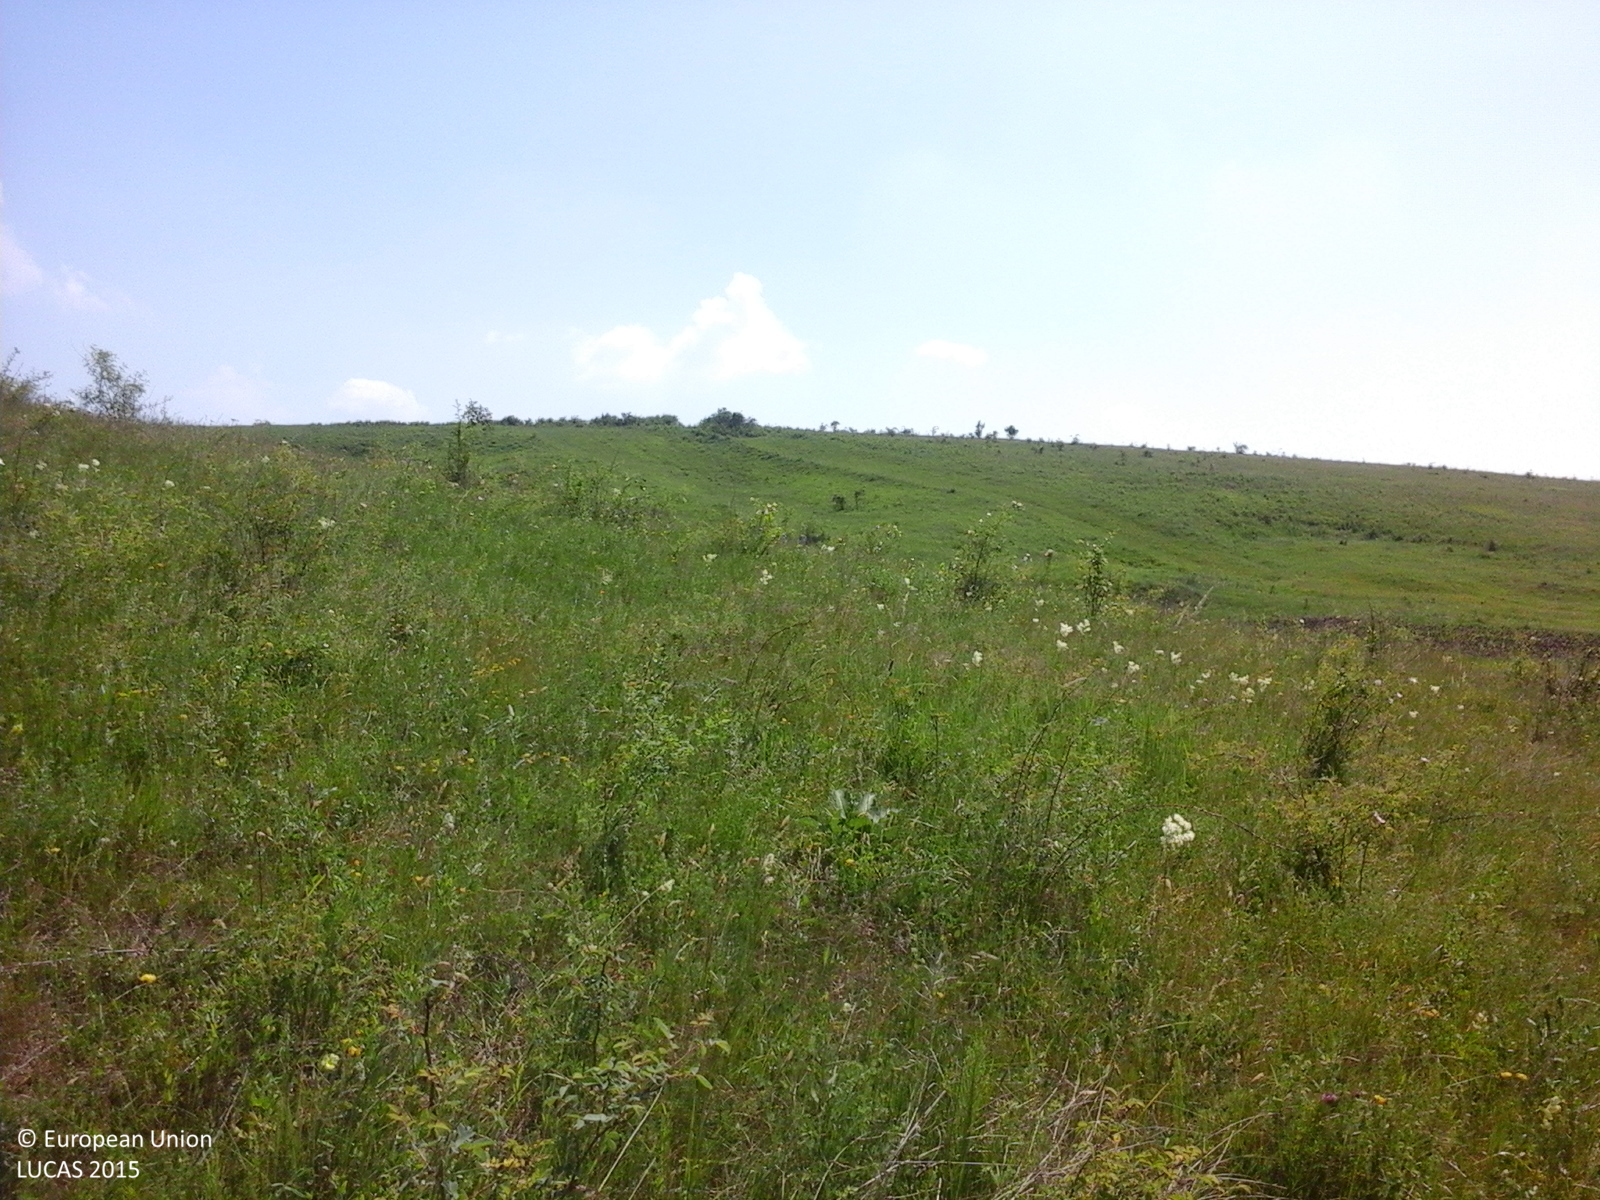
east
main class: Grassland
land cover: Grassland without tree/shrub cover
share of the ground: > 75 %
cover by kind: herbaceous plants 100 %
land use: Agriculture (excluding fallow land and kitchen gardens)
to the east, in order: Grassland without tree/shrub cover; Grassland with sparse tree/shrub cover
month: June
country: RO
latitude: 46.5556
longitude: 26.5580
